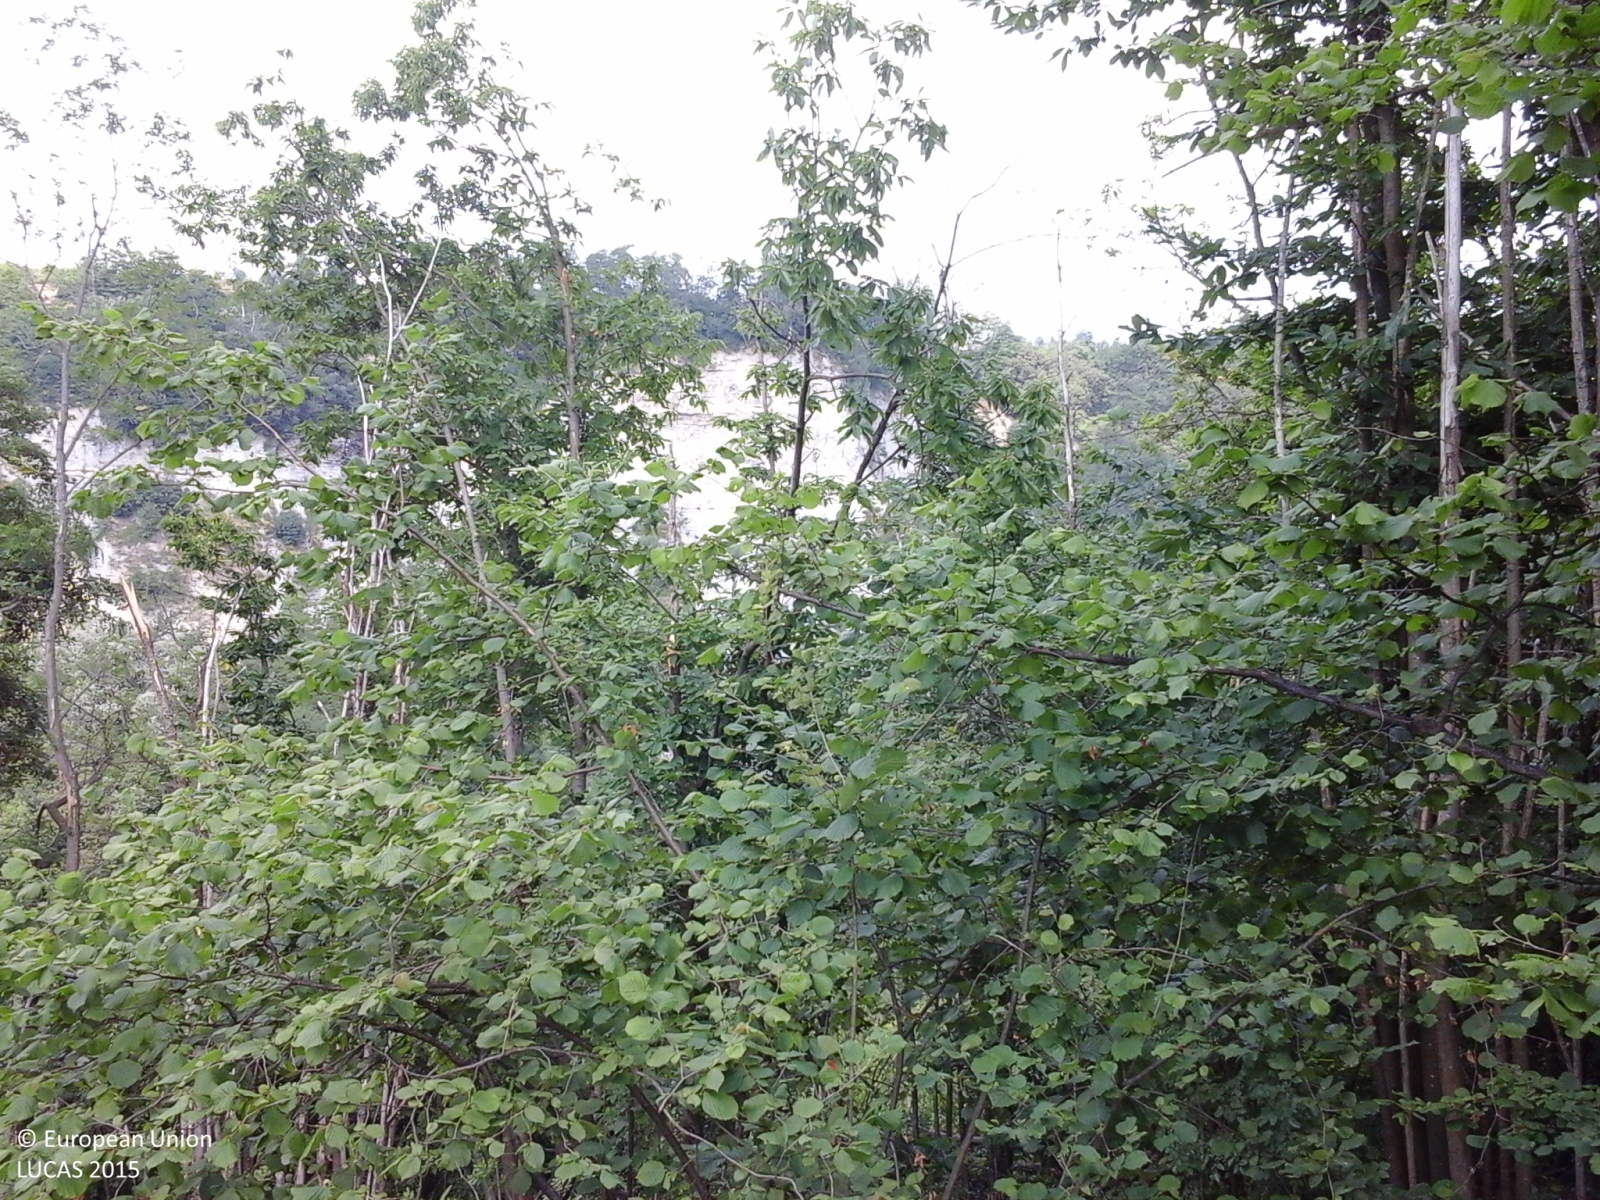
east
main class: Woodland
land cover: Broadleaved woodland
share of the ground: < 10 %
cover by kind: herbaceous plants 30 %, consolidated bare surface 30 %, broadleaved forest trees 20 %, shrubs 20 %
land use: Forestry
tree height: < 5 m
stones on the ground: 25 - 50 %
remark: Clear cut
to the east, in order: Broadleaved woodland; Rocks and stones; Broadleaved woodland
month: June
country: IT
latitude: 44.5735
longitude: 8.4544
